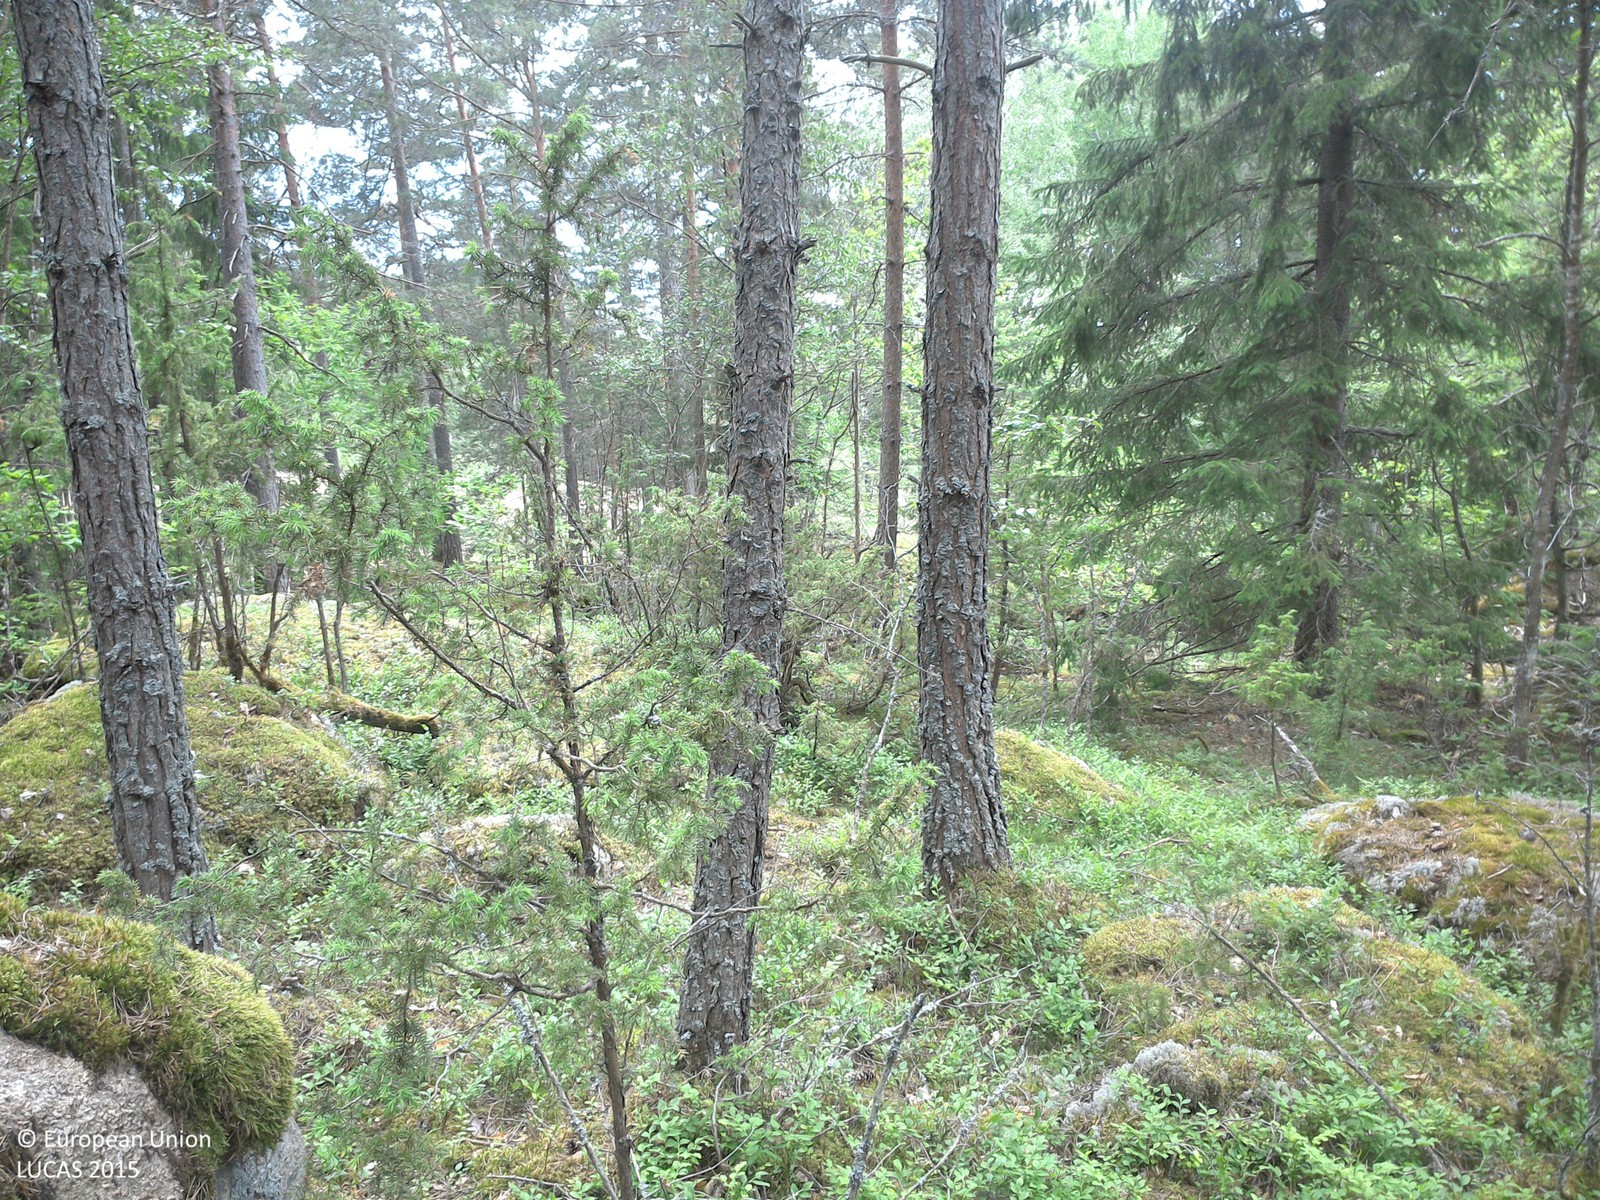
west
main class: Woodland
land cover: Pine dominated coniferous woodland
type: boreal forest
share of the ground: 50 - 75 %
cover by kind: coniferous forest trees 60 %, herbaceous plants 20 %, lichens and mosses 20 %
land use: Agriculture (excluding fallow land and kitchen gardens)
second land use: Forestry
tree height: > 5 m
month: June
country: SE
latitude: 58.3037
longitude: 15.5406
